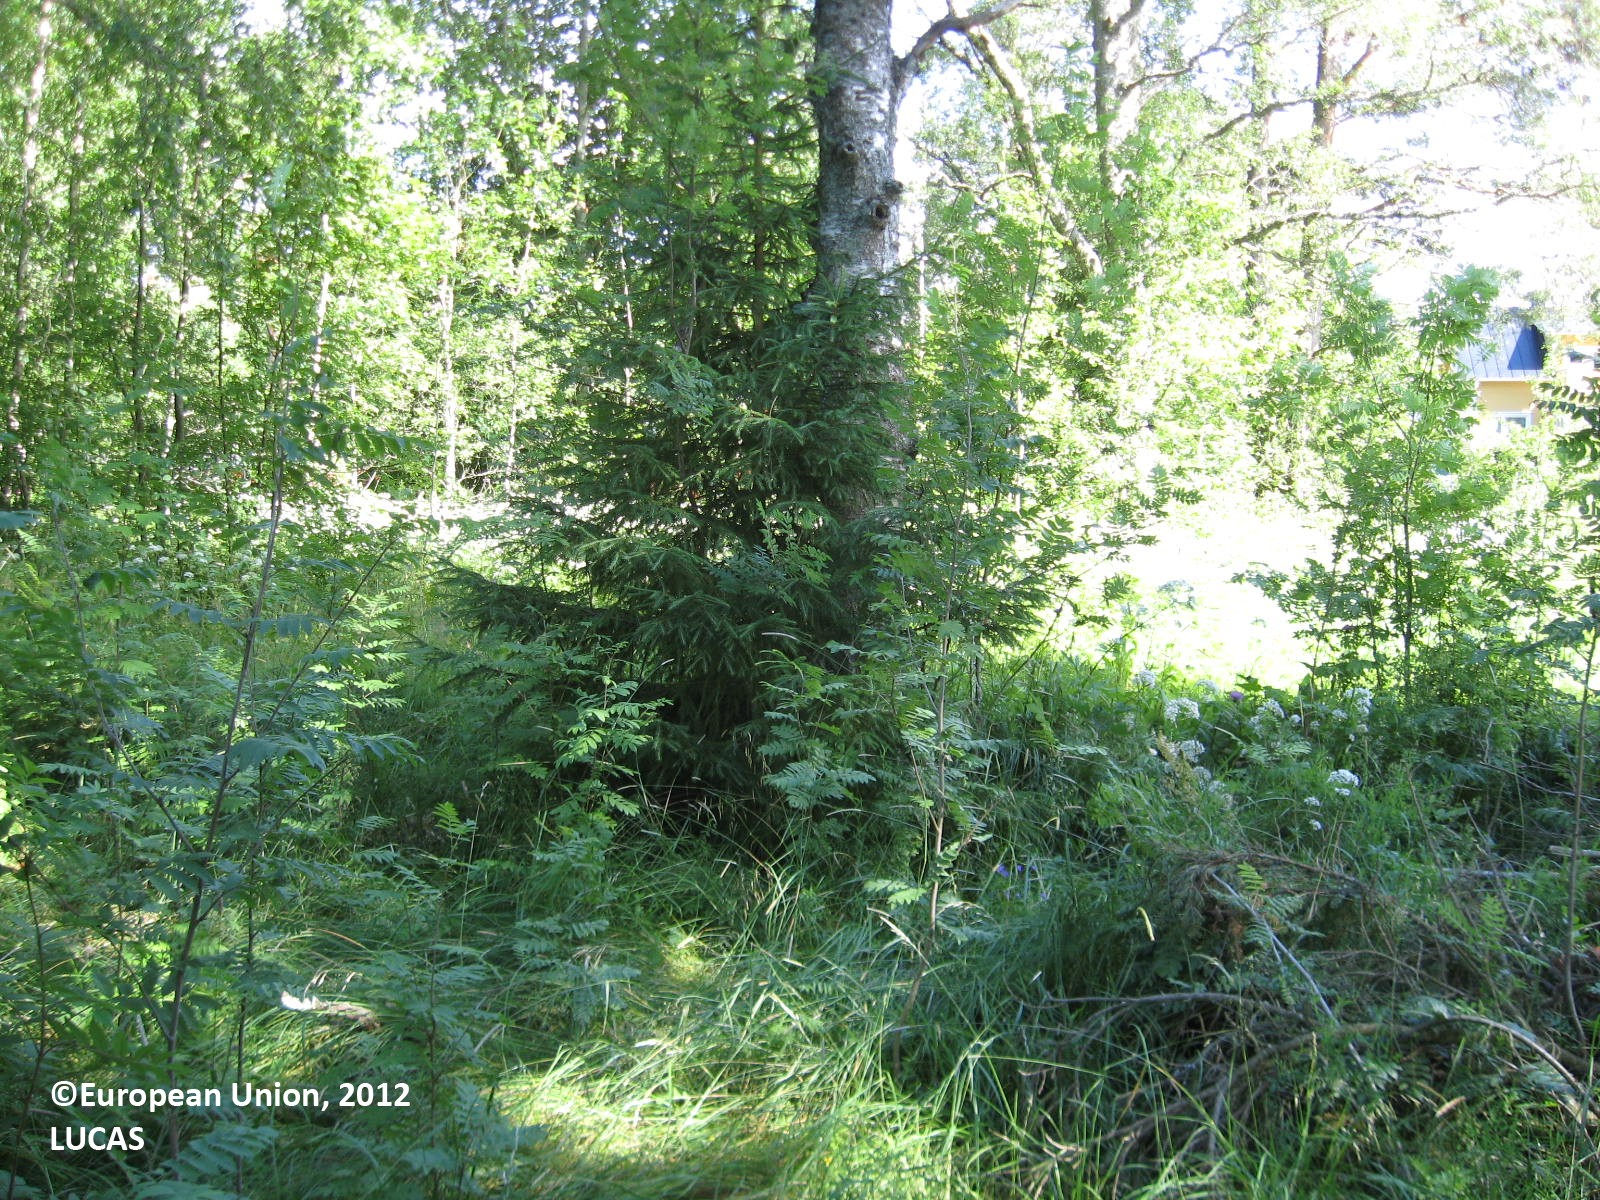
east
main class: Woodland
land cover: Other mixed woodland
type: boreal forest
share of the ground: > 75 %
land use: Community services
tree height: > 5 m
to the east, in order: Other mixed woodland; Shruby margins; Grassland without tree/shrub cover; Artificial constructions in urban areas
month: July
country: FI
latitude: 62.2700
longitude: 21.3906
